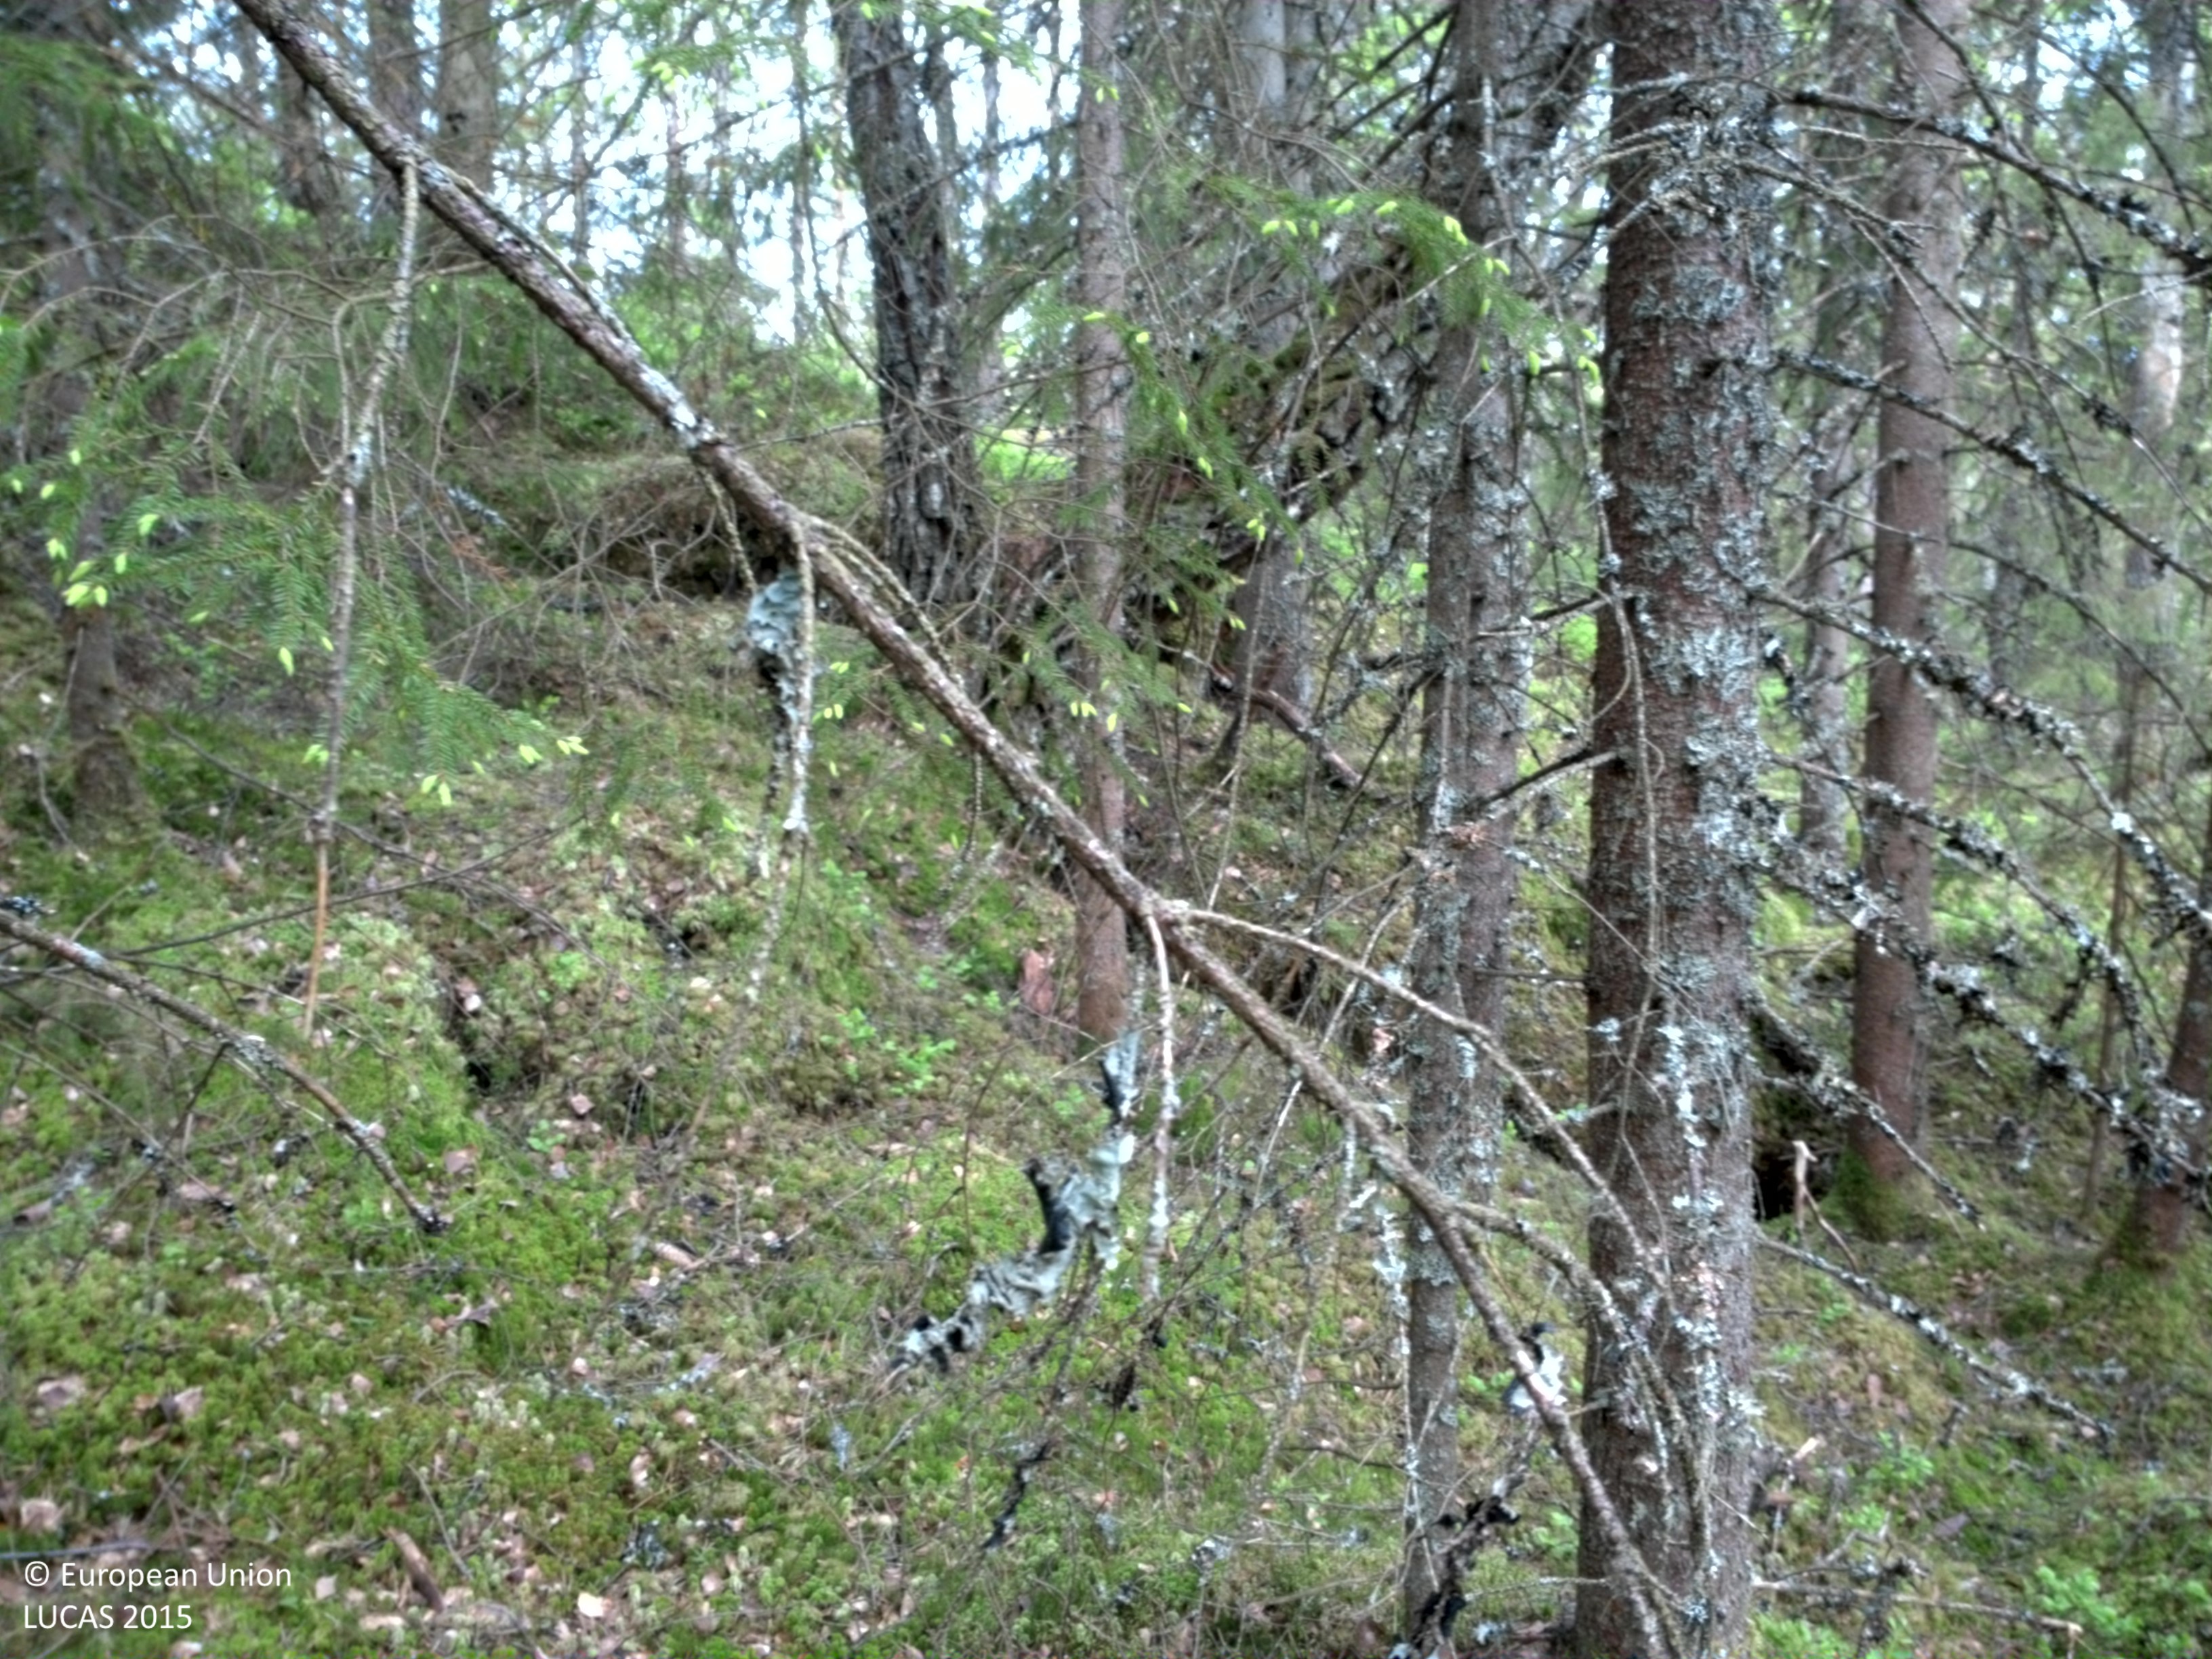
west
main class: Woodland
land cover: Spruce dominated coniferous woodland
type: boreal forest
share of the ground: 50 - 75 %
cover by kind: coniferous forest trees 60 %, shrubs 25 %, broadleaved forest trees 15 %
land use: Forestry
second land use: Amenities, museums, leisure
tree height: > 5 m
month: June
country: SE
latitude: 57.4623
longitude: 13.8463
